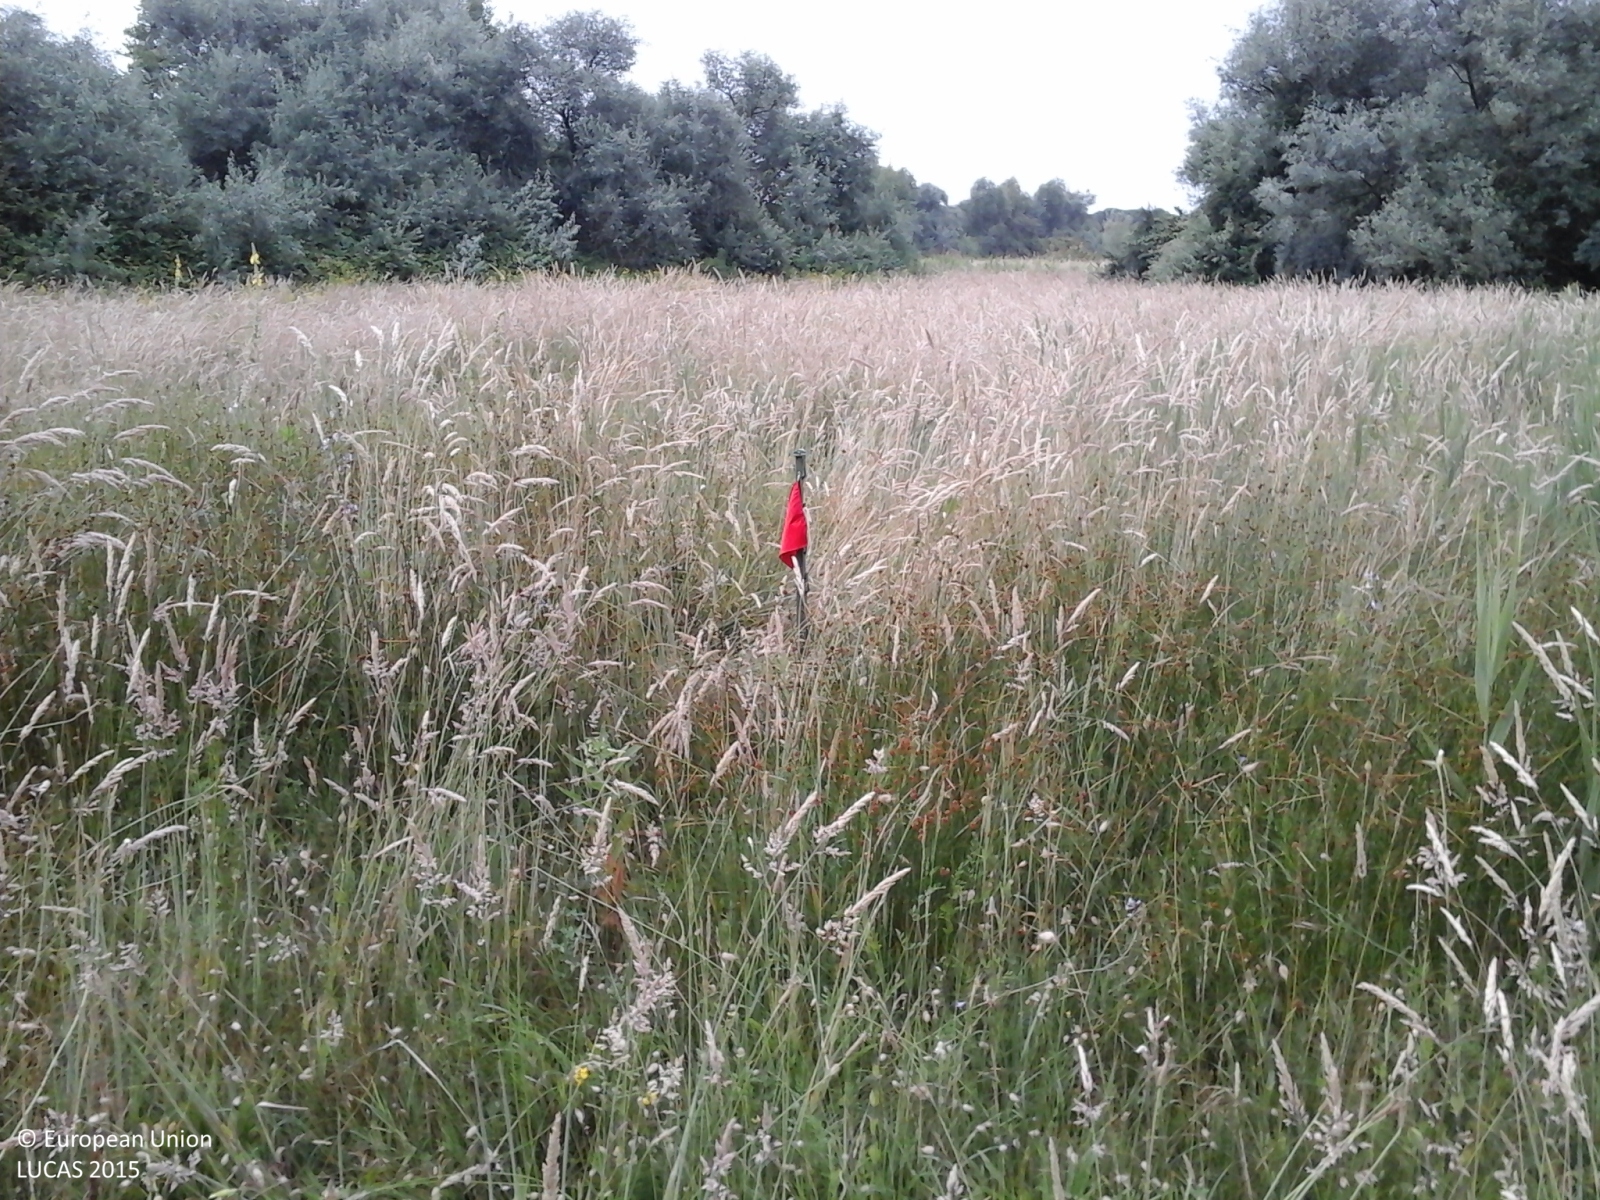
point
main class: Grassland
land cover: Grassland without tree/shrub cover
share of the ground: > 75 %
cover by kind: herbaceous plants 100 %
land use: Agriculture (excluding fallow land and kitchen gardens)
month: June
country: IT
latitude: 44.5968
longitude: 12.2505
